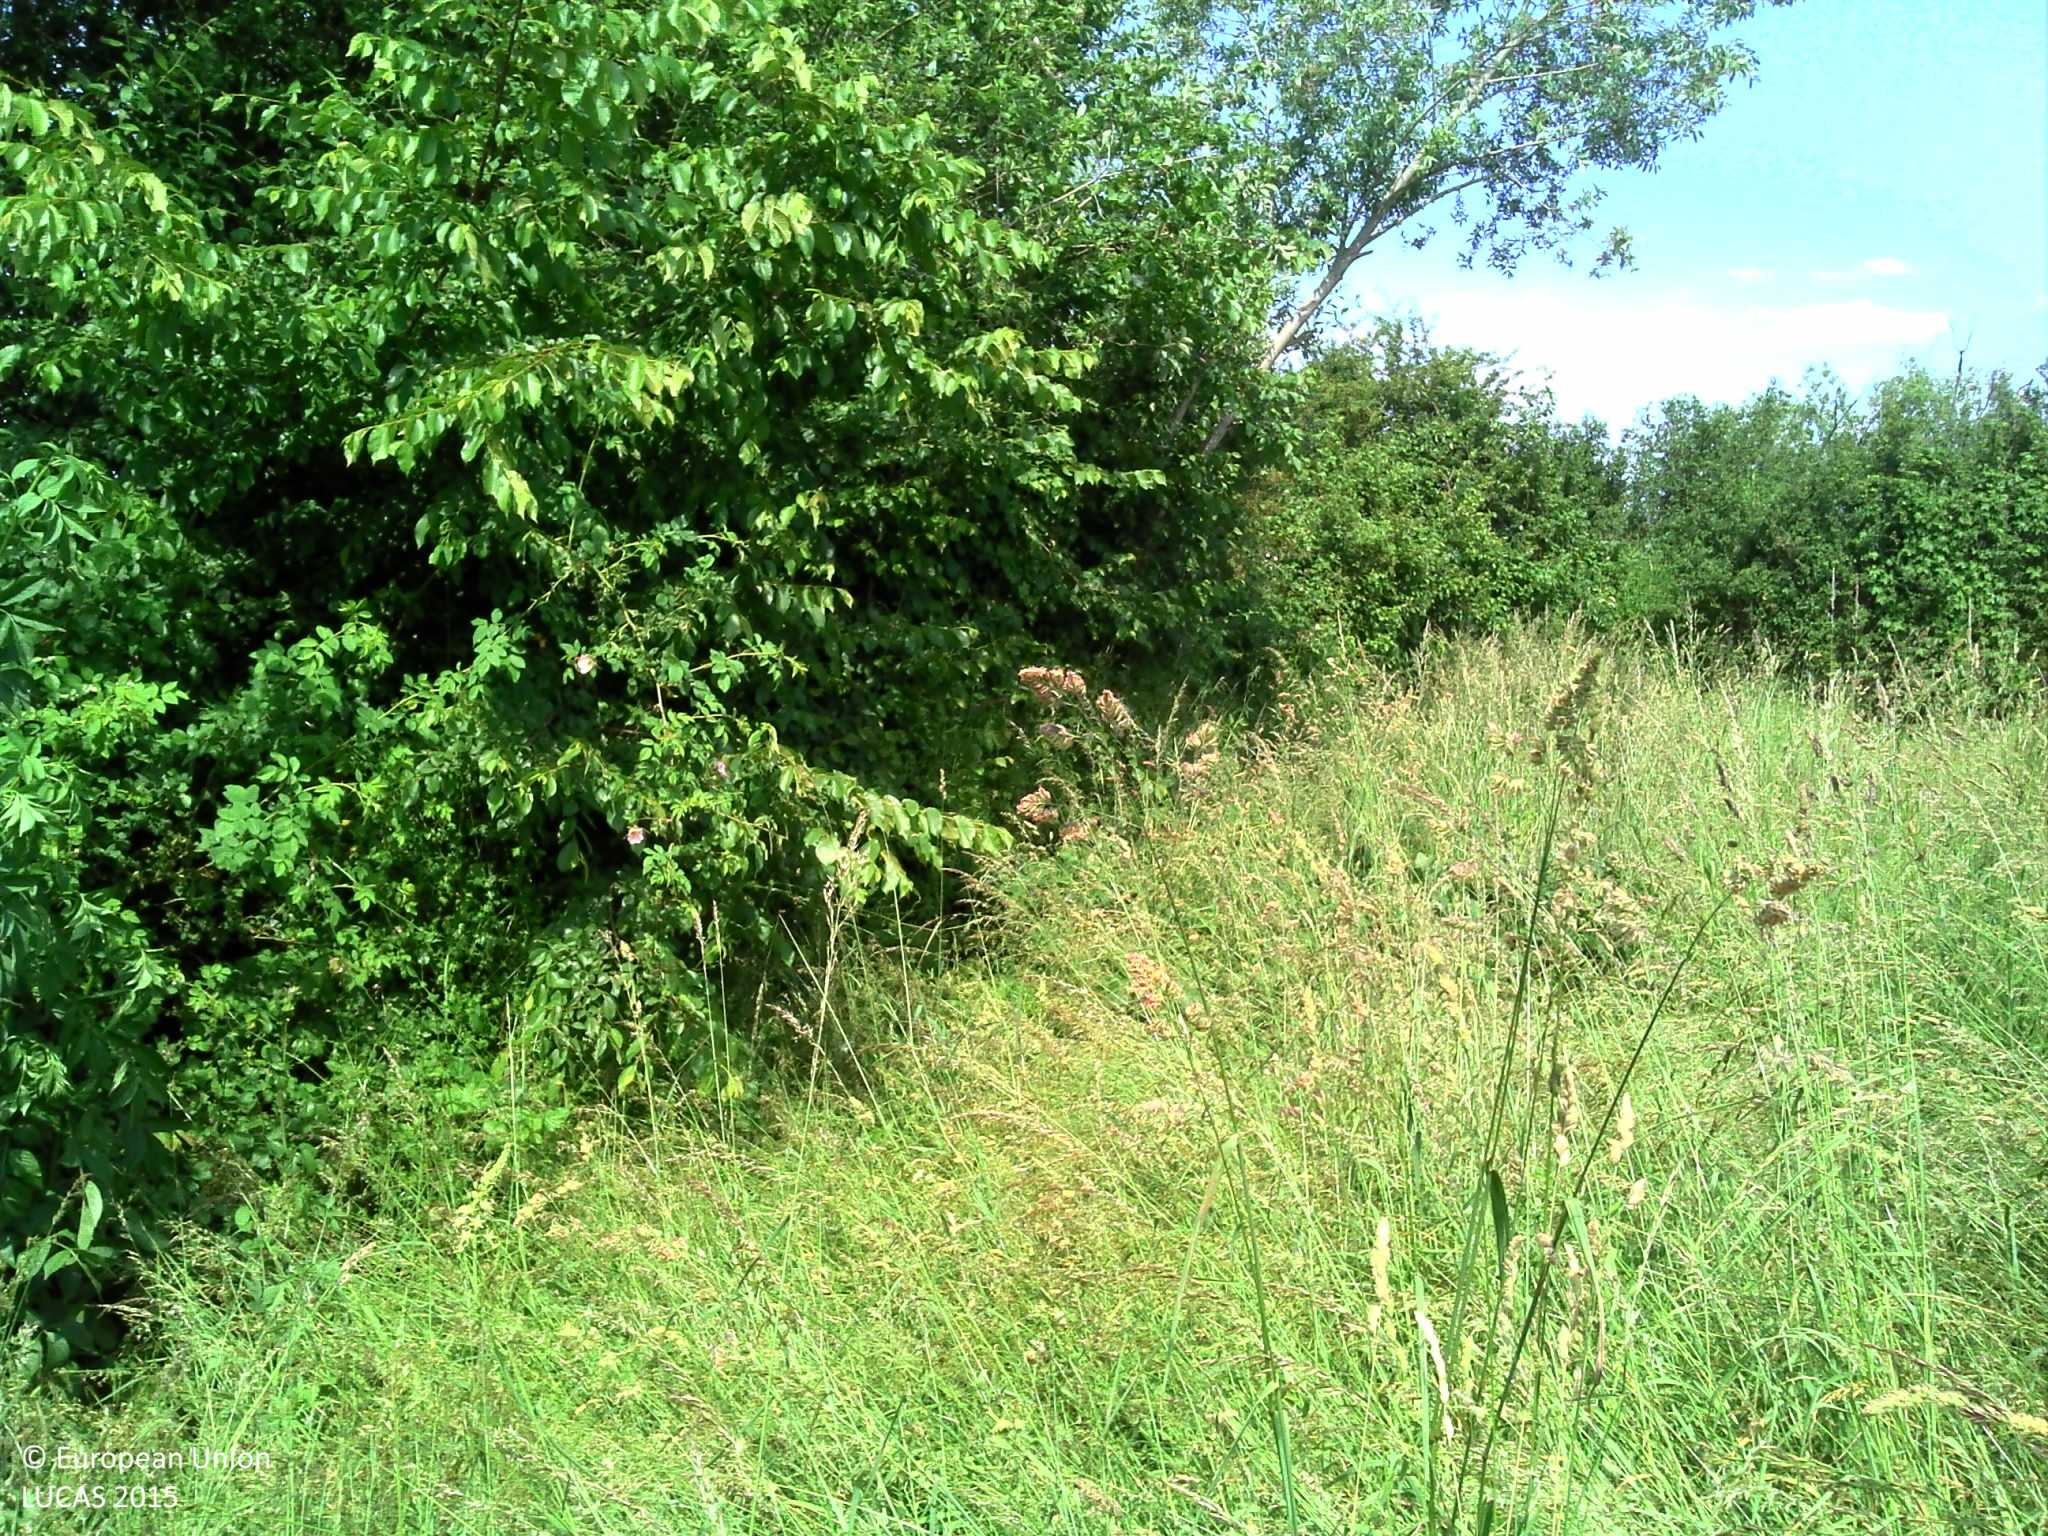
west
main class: Grassland
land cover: Grassland without tree/shrub cover
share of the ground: > 75 %
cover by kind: herbaceous plants 100 %
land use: Agriculture (excluding fallow land and kitchen gardens)
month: June
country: FR
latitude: 46.7921
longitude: 2.7507
